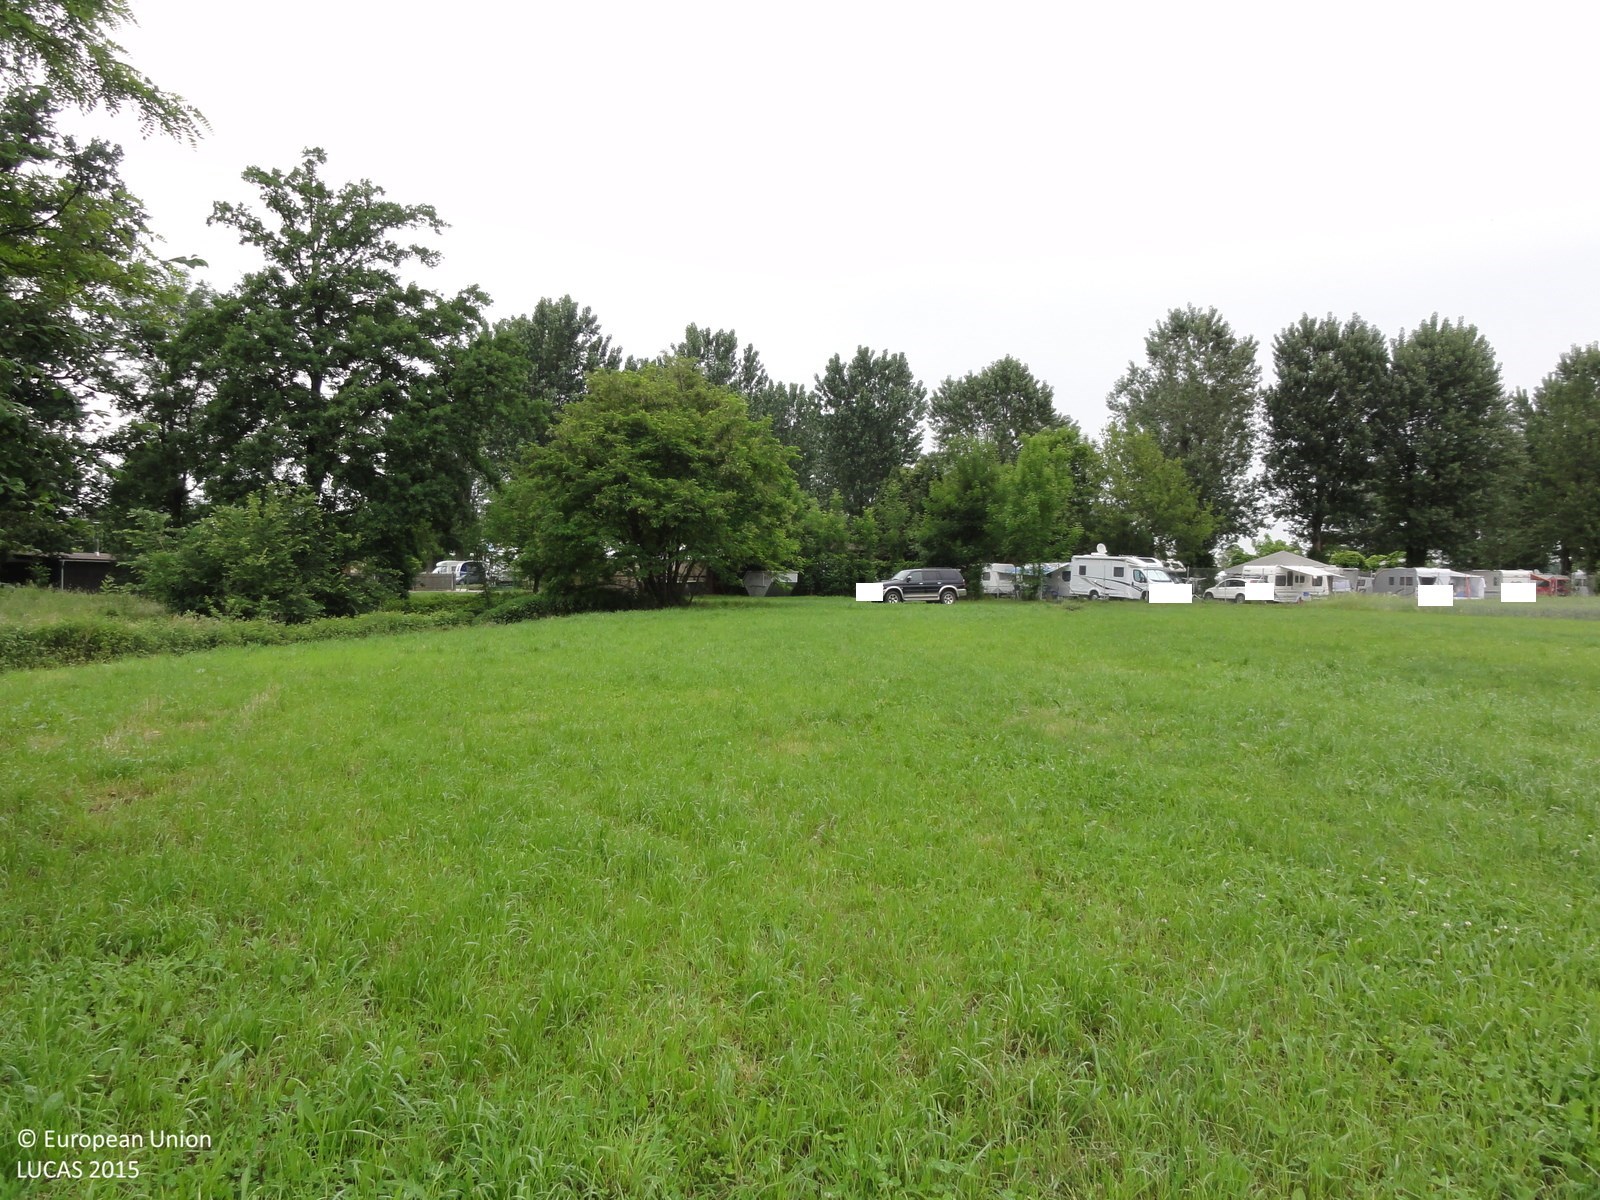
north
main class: Grassland
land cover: Grassland without tree/shrub cover
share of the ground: > 75 %
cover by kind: herbaceous plants 100 %
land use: Agriculture (excluding fallow land and kitchen gardens)
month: May
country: SI
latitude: 46.5703
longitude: 16.1716
